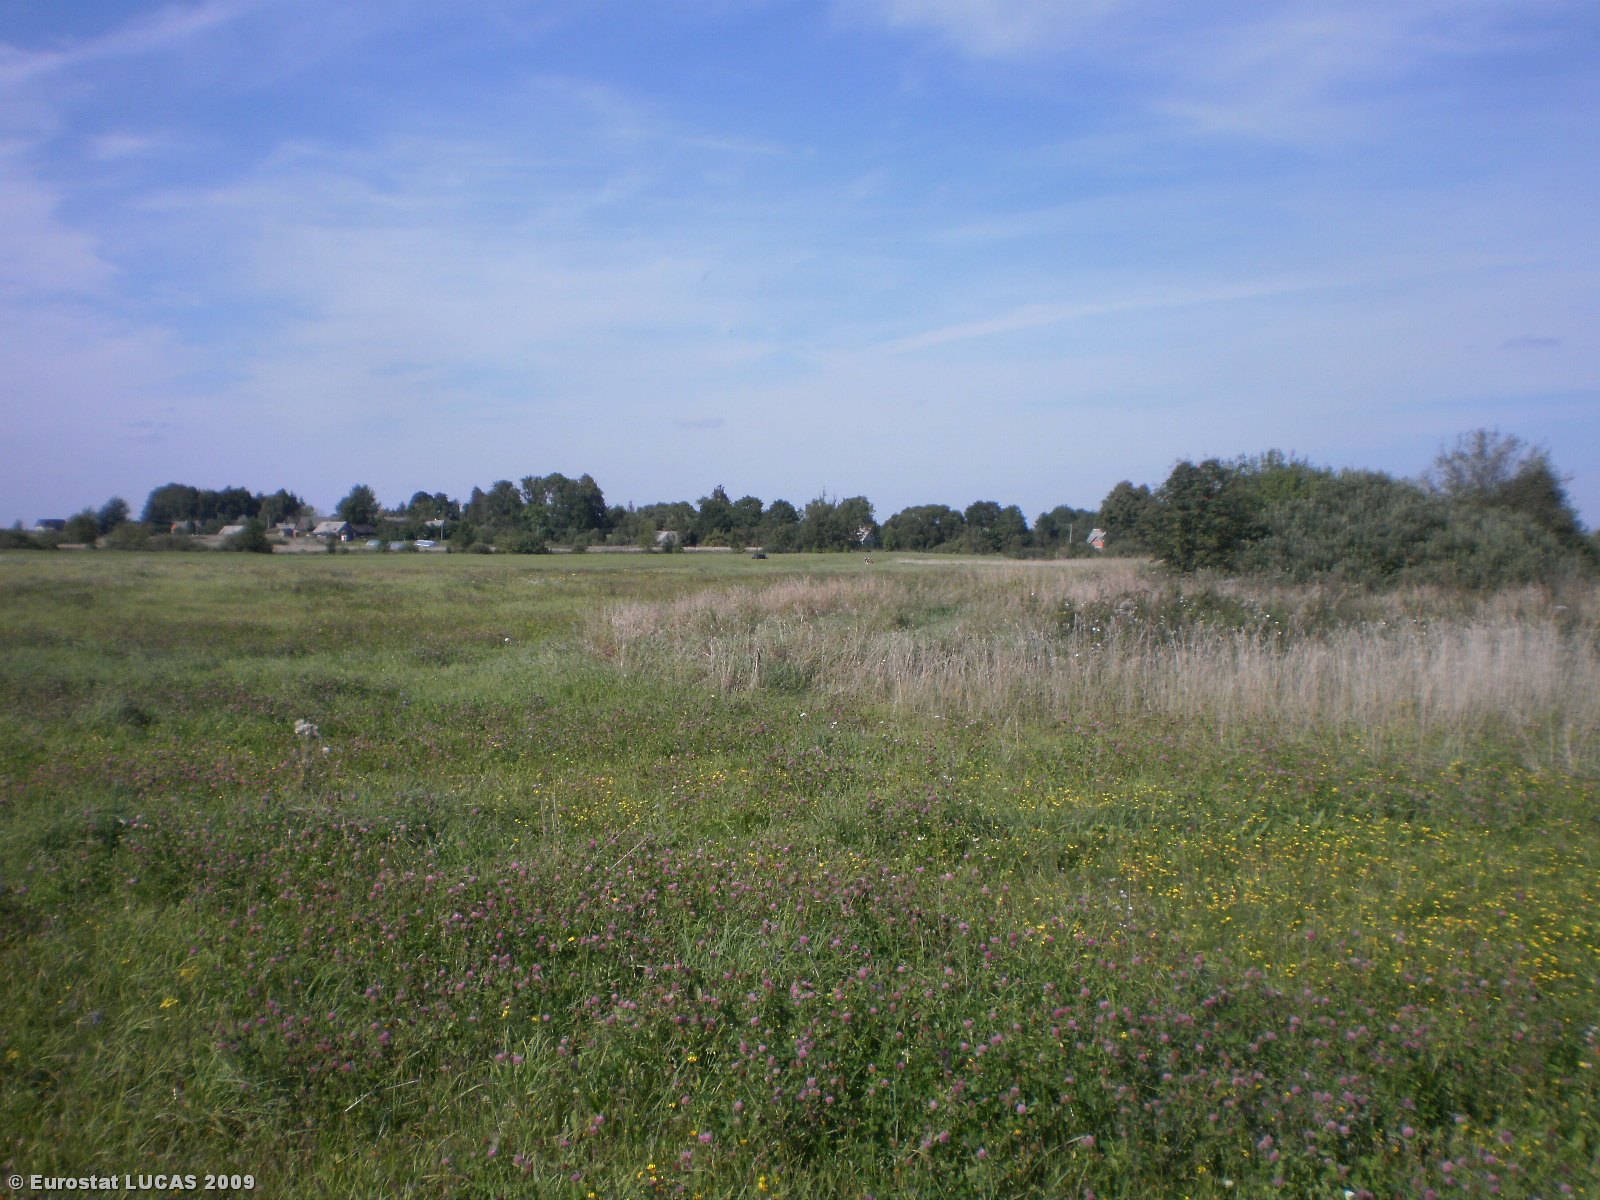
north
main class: Grassland
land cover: Grassland without tree/shrub cover
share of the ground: > 75 %
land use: Agriculture (excluding fallow land and kitchen gardens)
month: August
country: LT
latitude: 54.9288
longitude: 24.5697
